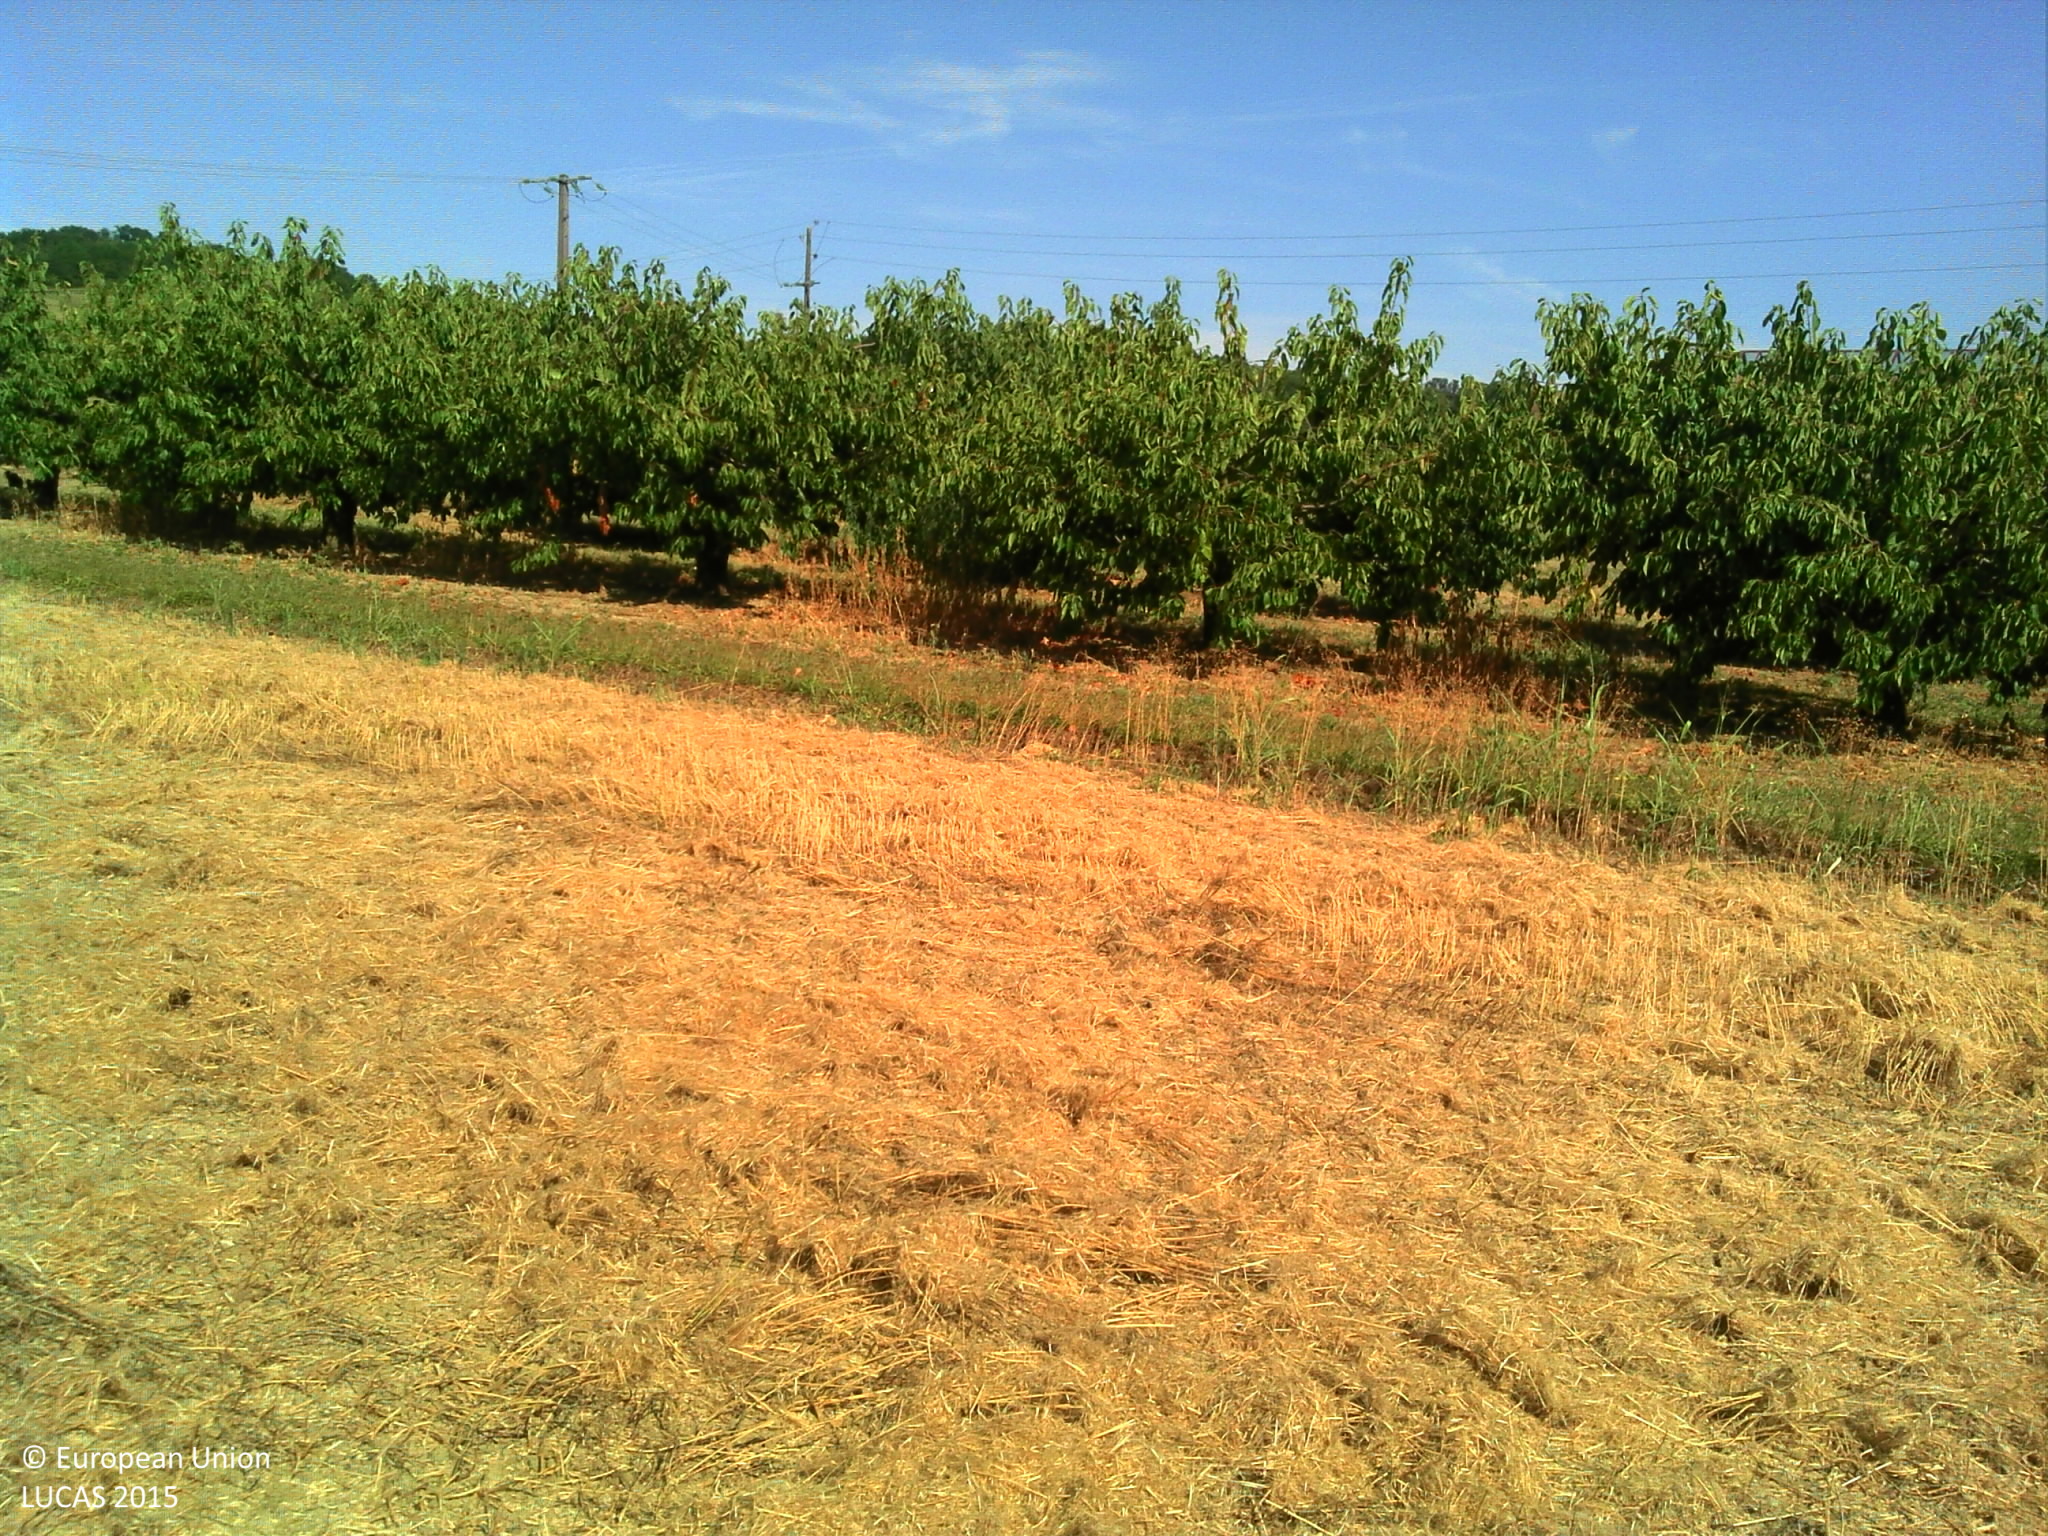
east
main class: Cropland
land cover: Common wheat
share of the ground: 50 - 75 %
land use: Agriculture (excluding fallow land and kitchen gardens)
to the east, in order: Common wheat; Grassland without tree/shrub cover; Cherry fruit; Electric lines; Ditches and canals; Paved roads, cycling and walking lanes; Ditches and canals; Common wheat; Electric lines; Common wheat; Fences; Lucerne; Fences; Durum wheat
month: July
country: FR
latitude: 44.1009
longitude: 0.9656
